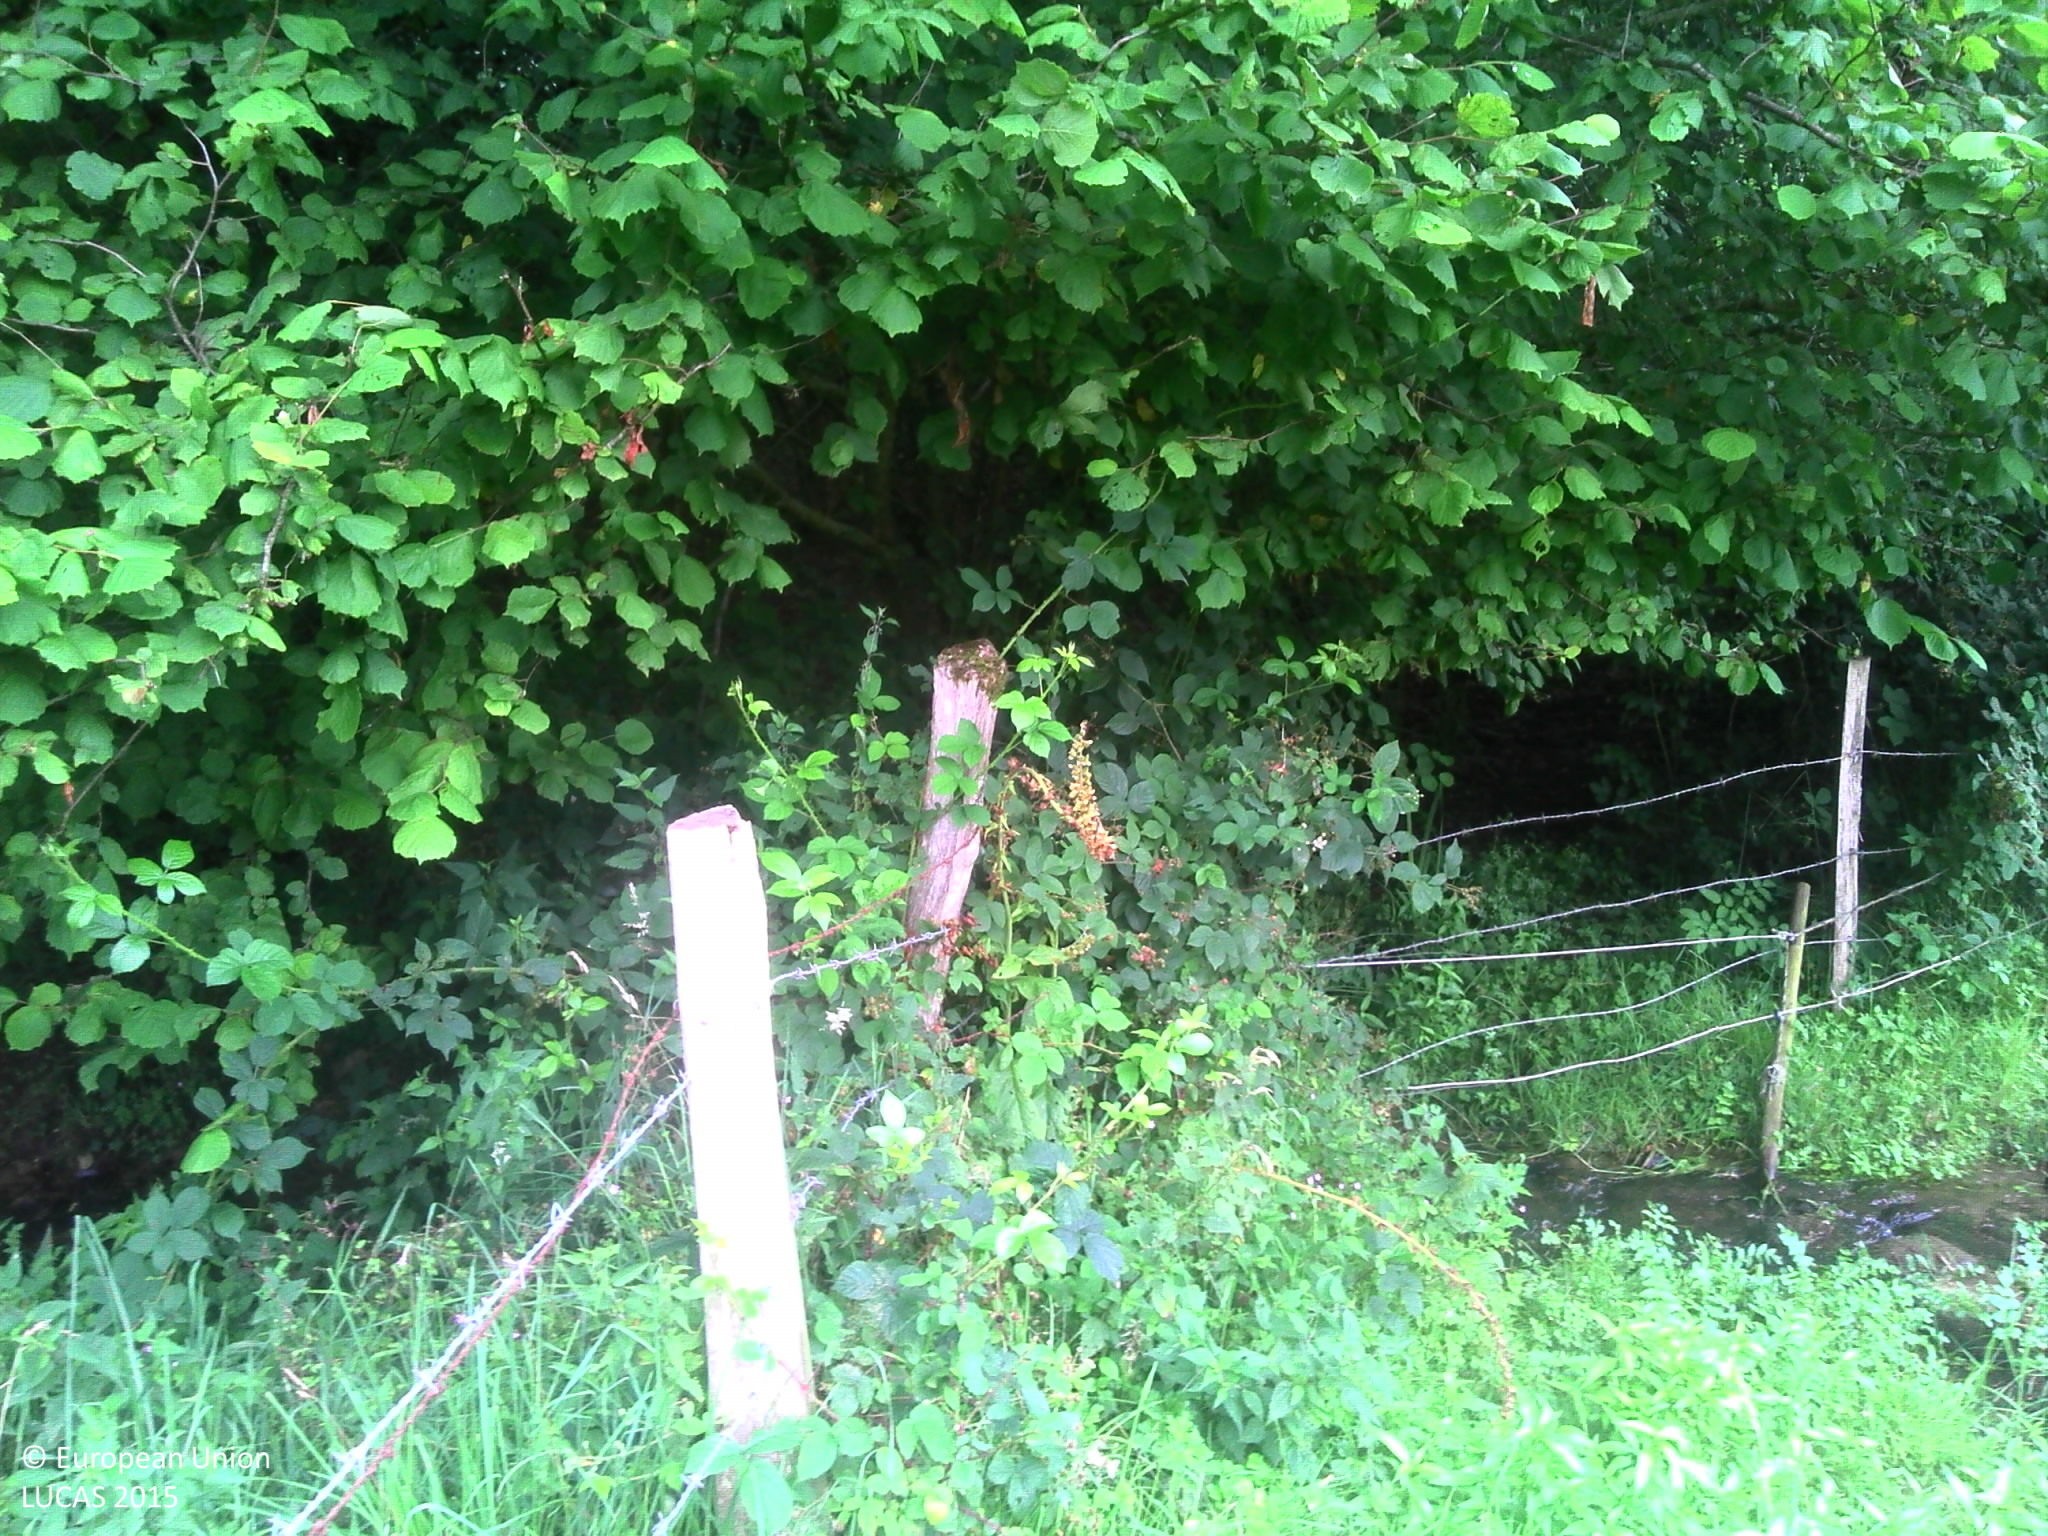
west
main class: Grassland
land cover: Grassland without tree/shrub cover
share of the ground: > 75 %
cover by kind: herbaceous plants 100 %
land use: Agriculture (excluding fallow land and kitchen gardens)
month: July
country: FR
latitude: 48.7589
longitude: -1.3776
